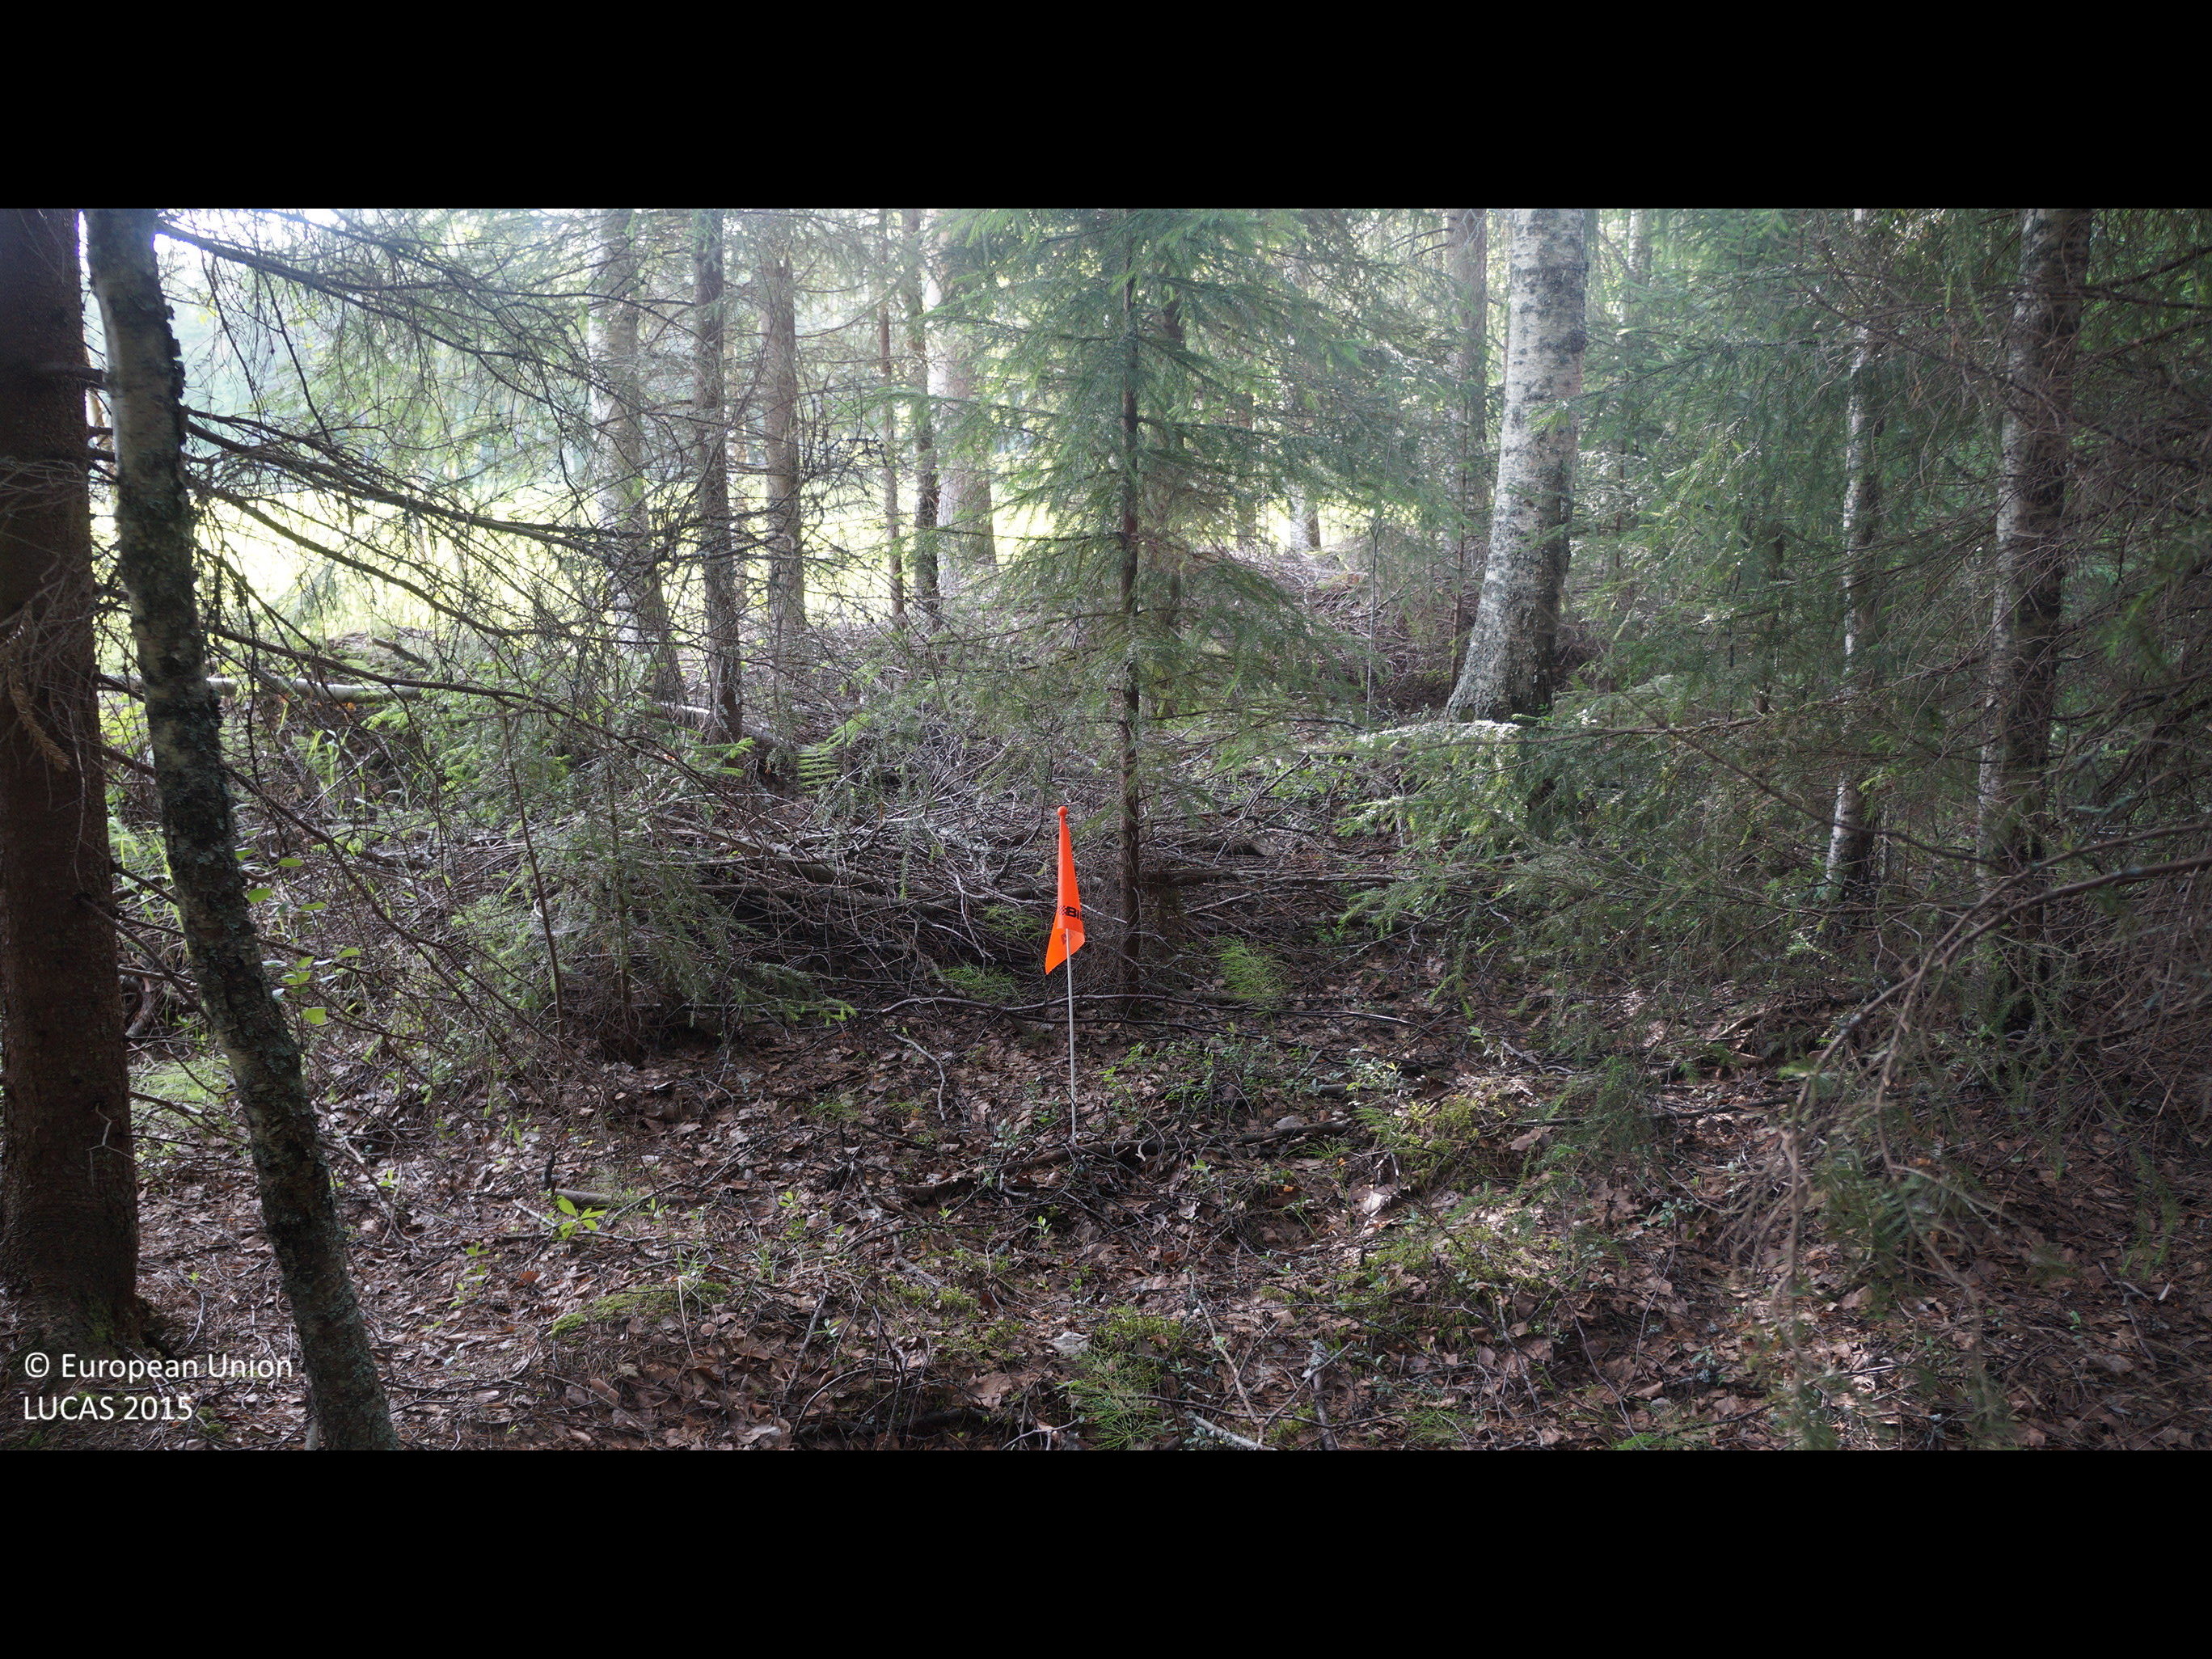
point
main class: Woodland
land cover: Spruce dominated mixed woodland
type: boreal forest
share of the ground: > 75 %
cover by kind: coniferous forest trees 50 %, broadleaved forest trees 35 %, shrubs 10 %, lichens and mosses 5 %
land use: Forestry
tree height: > 5 m
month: July
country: FI
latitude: 64.6488
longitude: 24.7031
